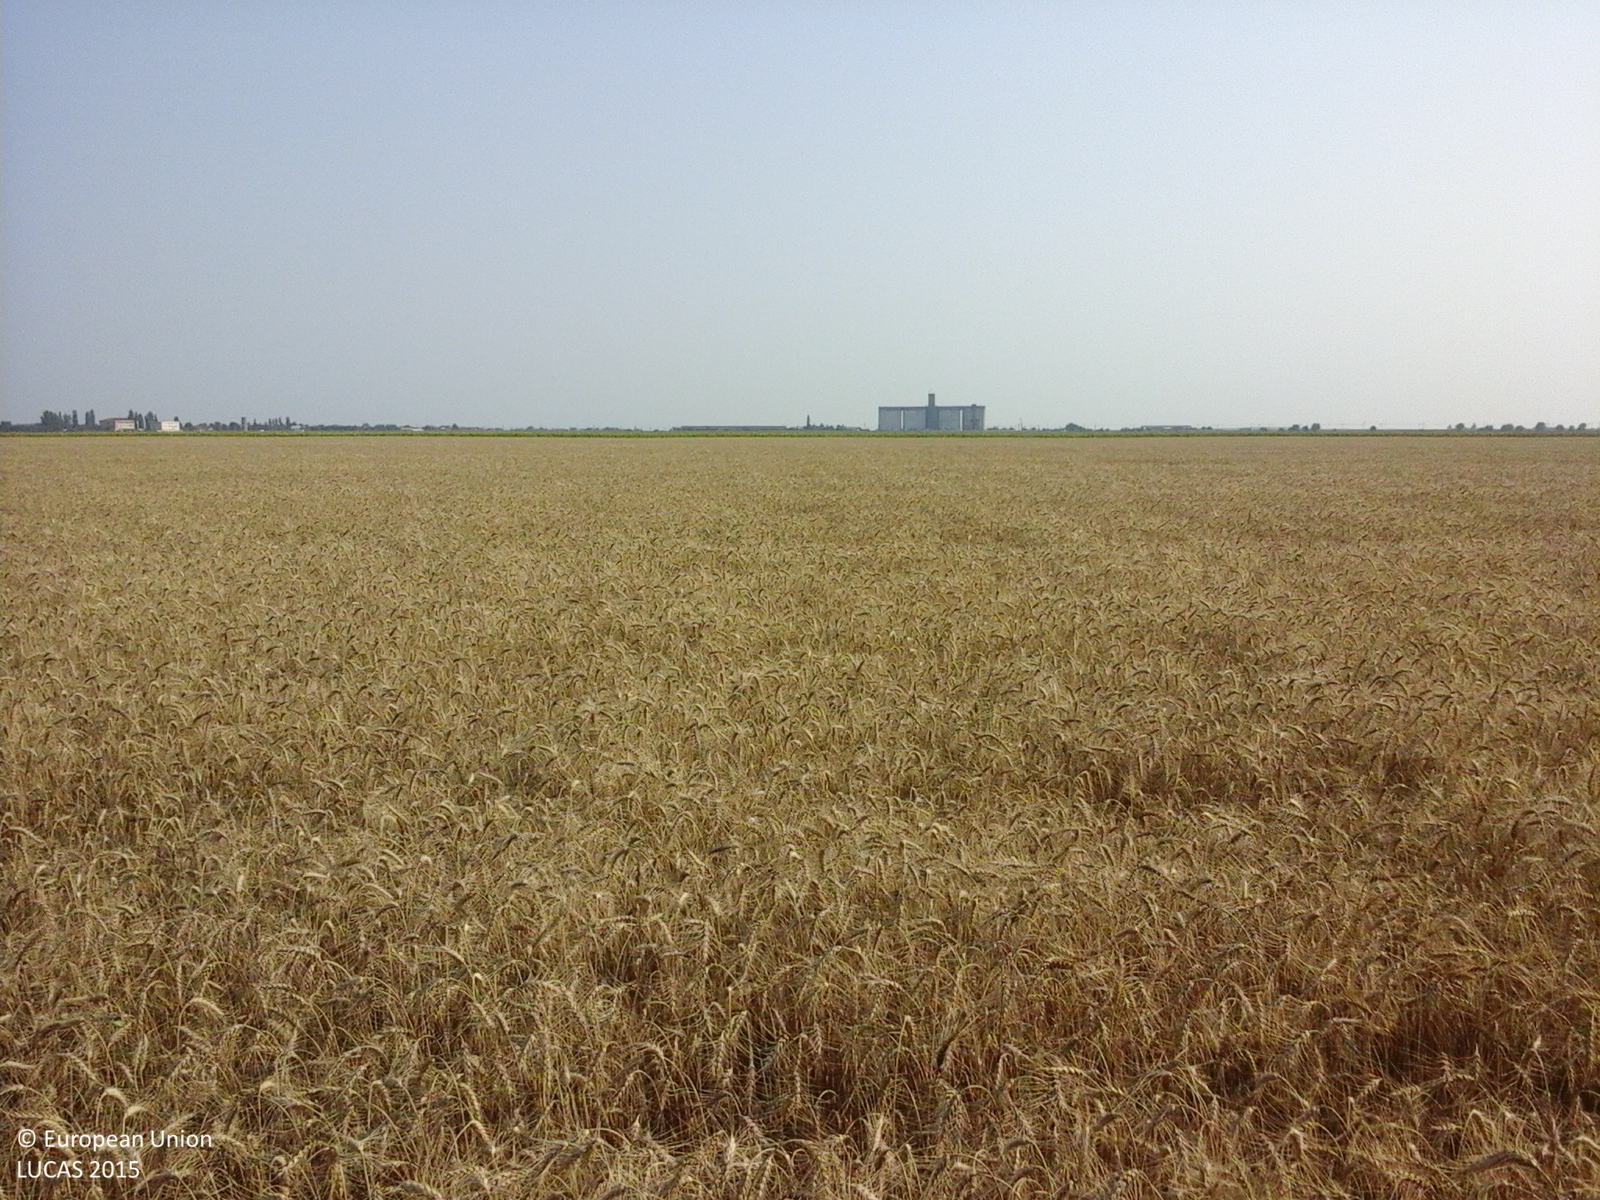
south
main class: Cropland
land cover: Common wheat
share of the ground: > 75 %
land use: Agriculture (excluding fallow land and kitchen gardens)
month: July
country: RO
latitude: 44.4650
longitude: 26.6480
